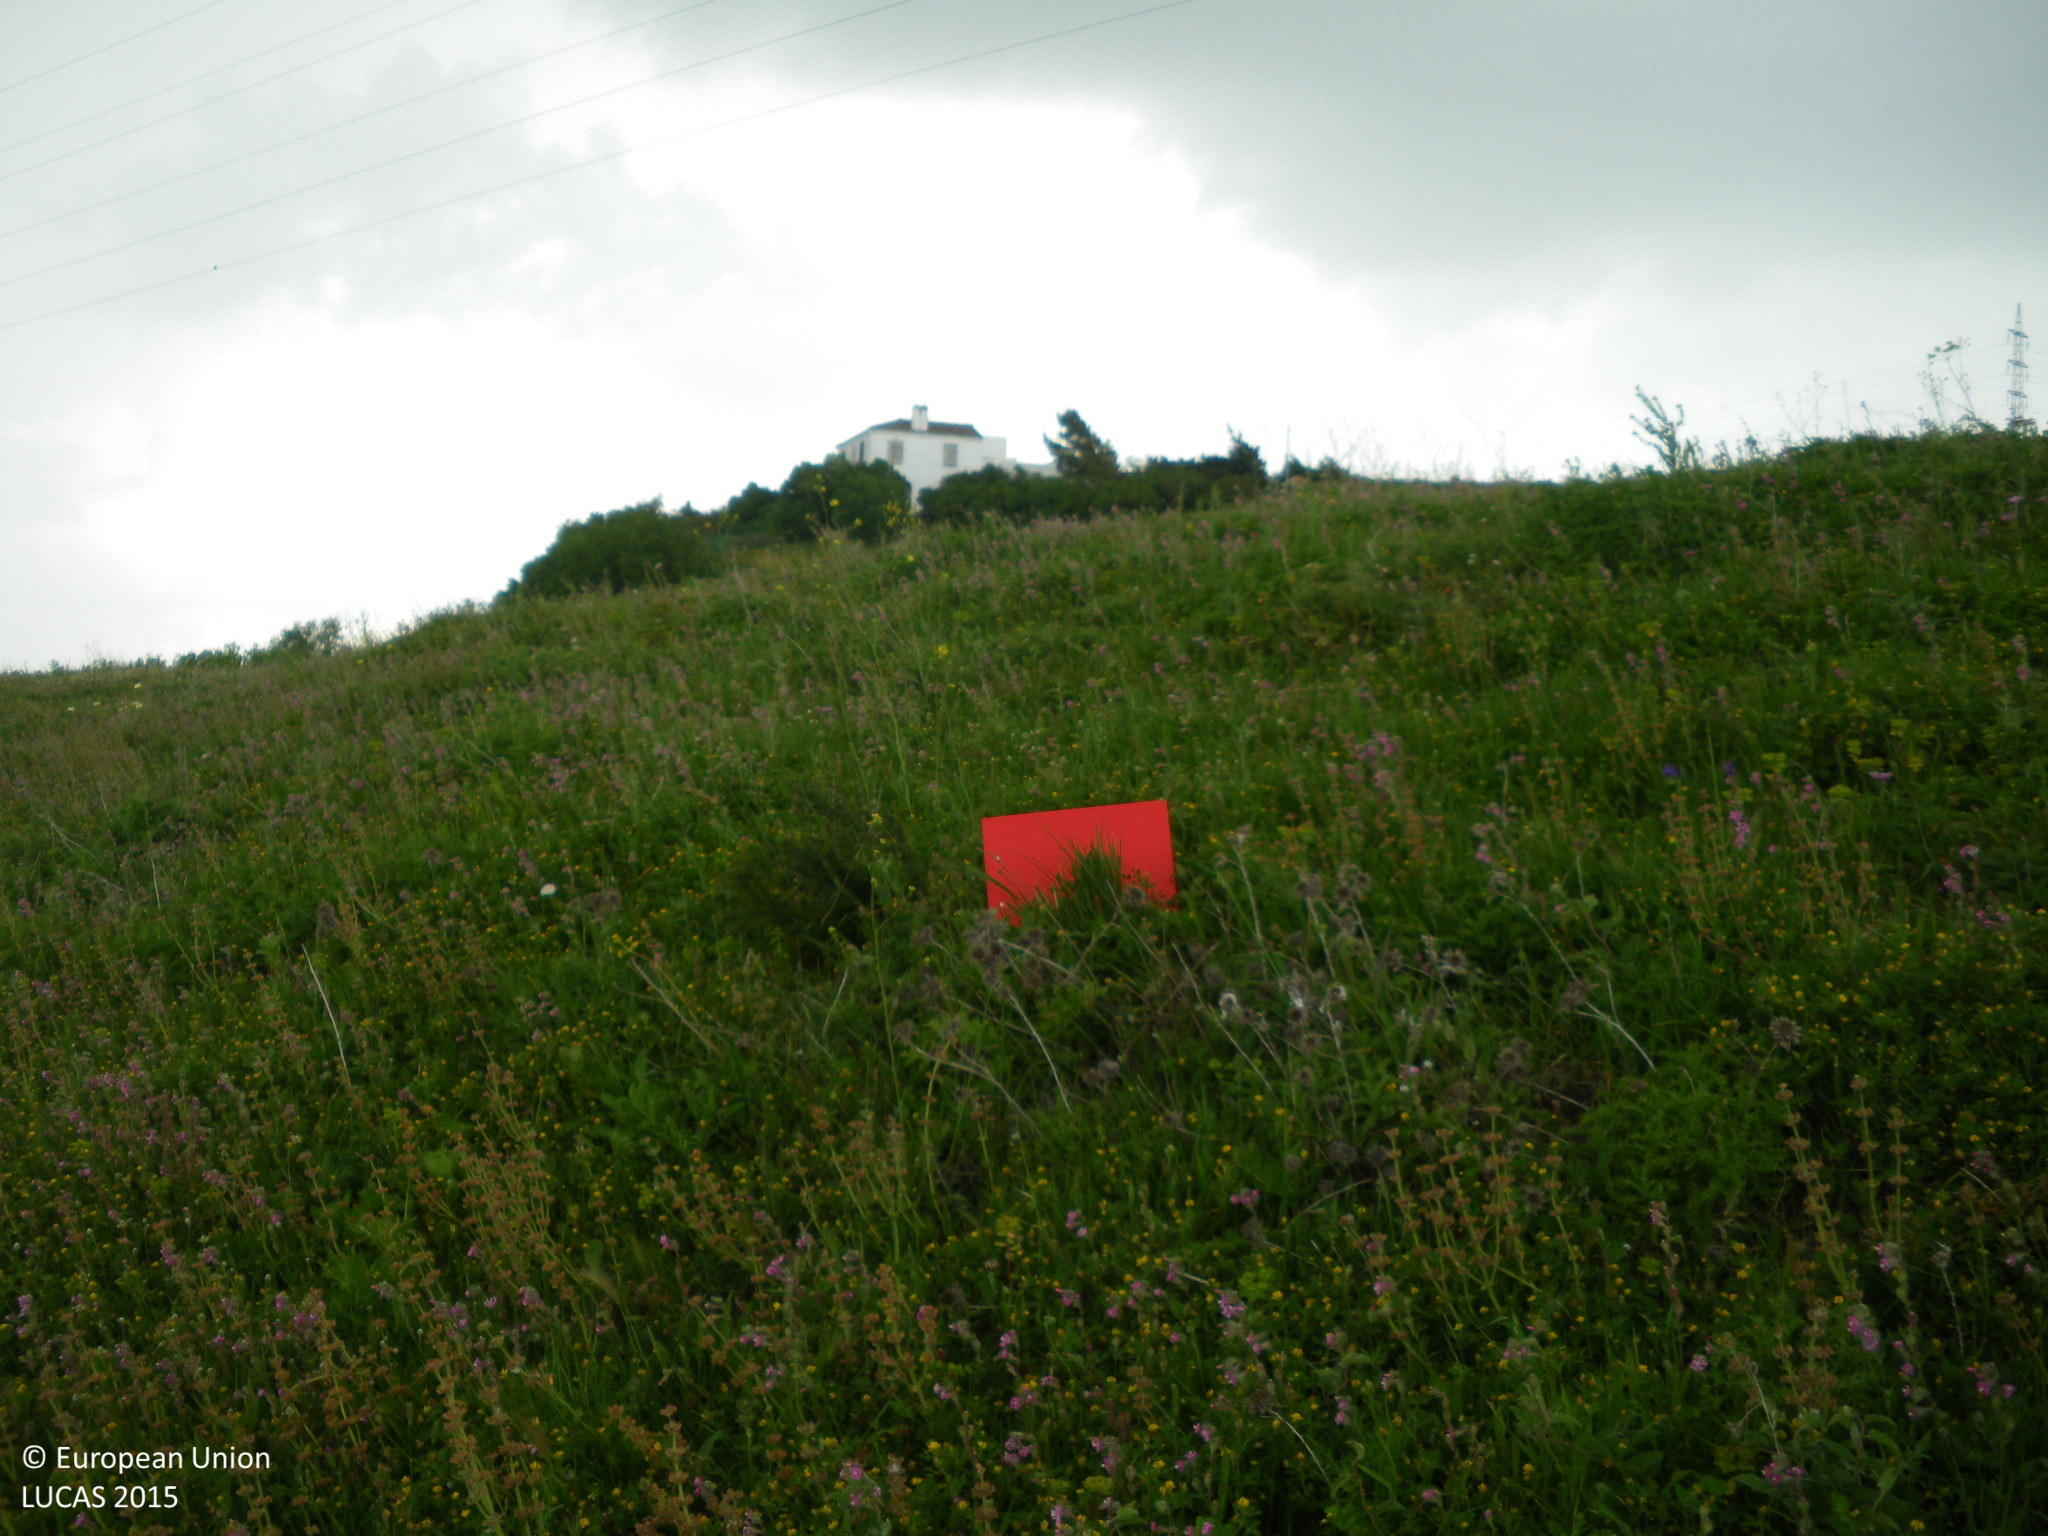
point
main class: Grassland
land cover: Grassland without tree/shrub cover
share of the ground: > 75 %
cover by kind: herbaceous plants 100 %
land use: Agriculture (excluding fallow land and kitchen gardens)
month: April
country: ES
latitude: 36.4691
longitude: -5.9299
